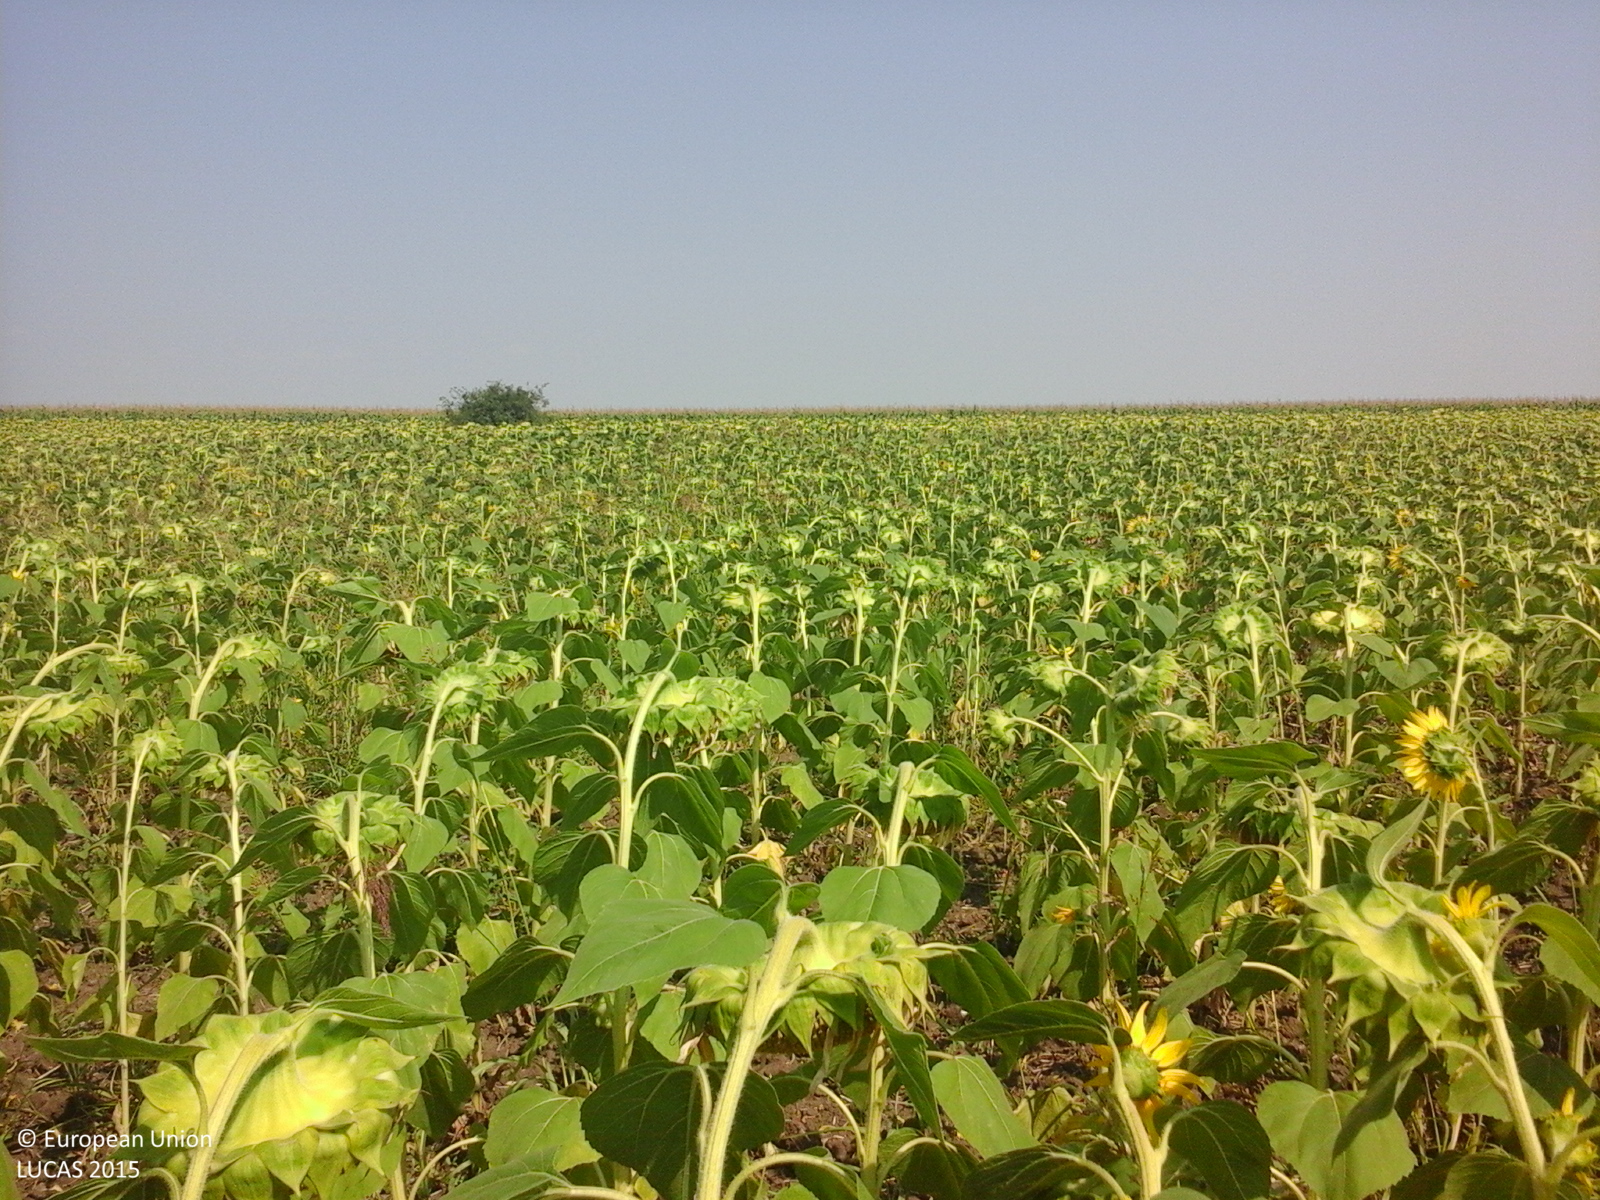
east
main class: Cropland
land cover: Sunflower
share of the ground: > 75 %
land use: Agriculture (excluding fallow land and kitchen gardens)
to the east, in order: Sunflower; Maize
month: July
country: RO
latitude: 45.6259
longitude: 27.8529
